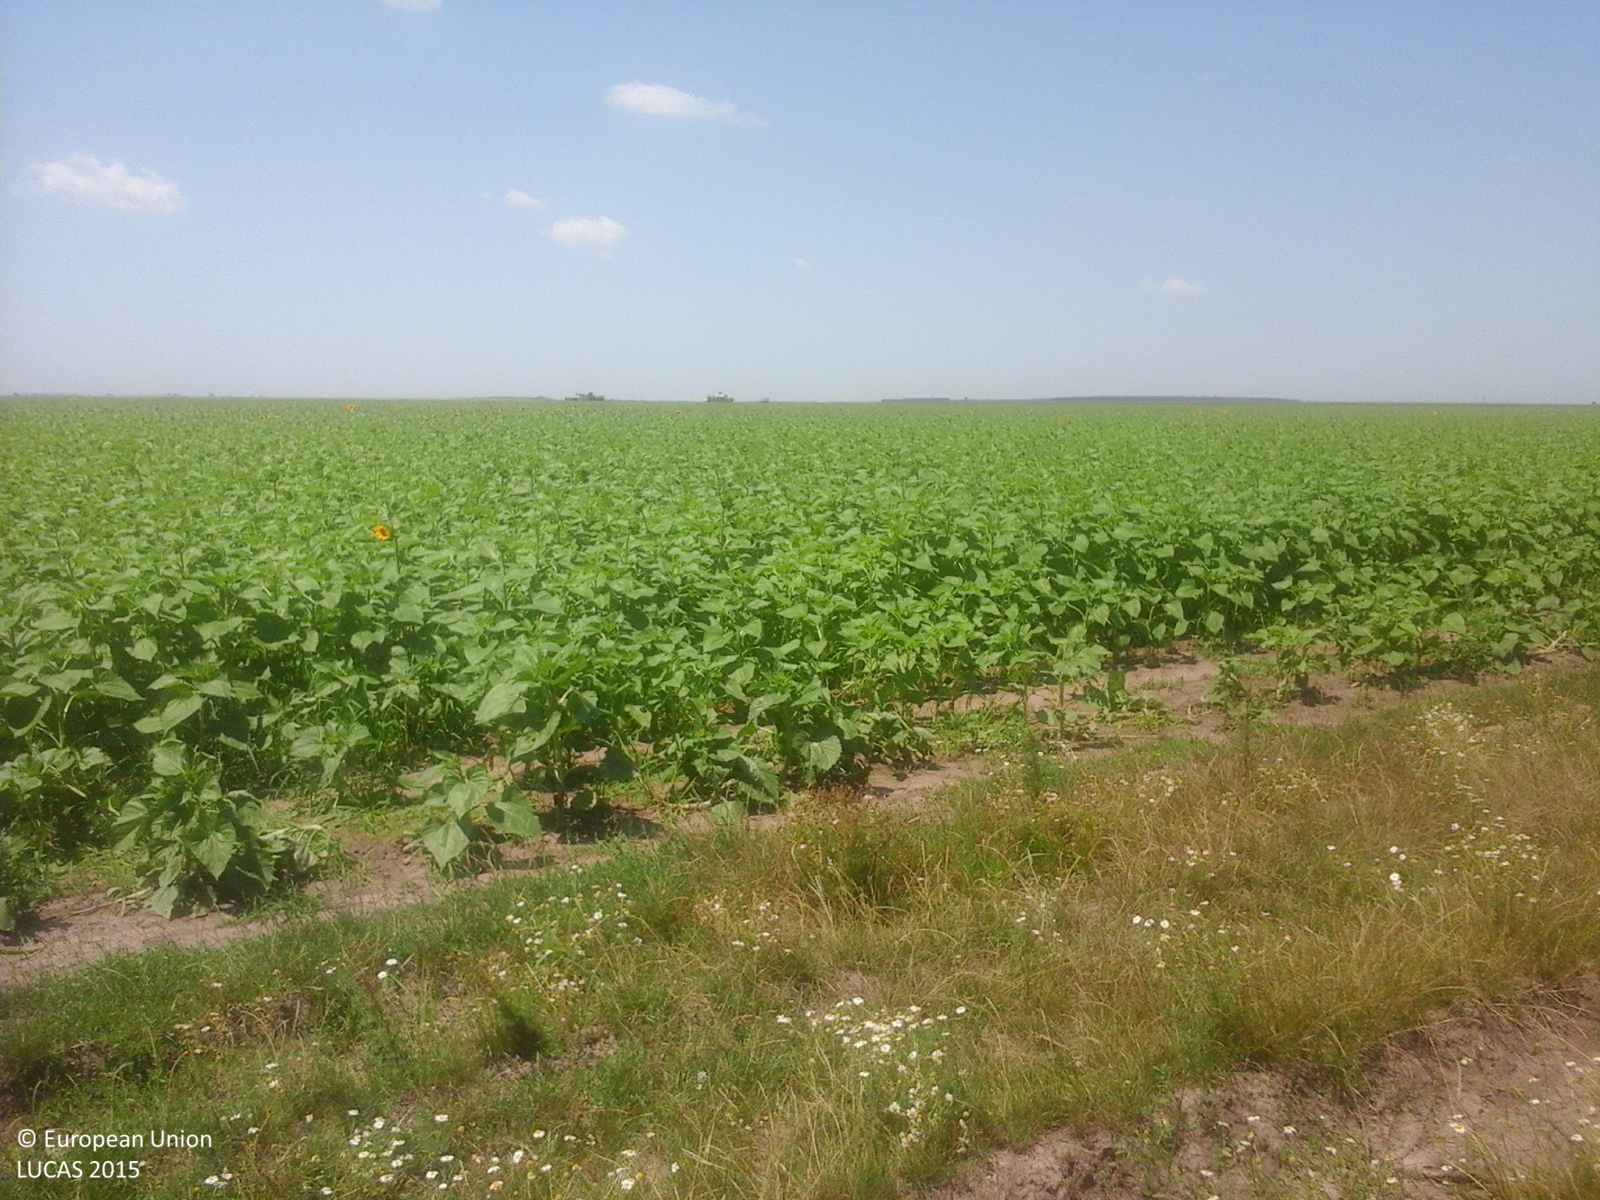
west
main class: Cropland
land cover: Sunflower
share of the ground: > 75 %
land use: Agriculture (excluding fallow land and kitchen gardens)
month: July
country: RO
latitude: 44.2084
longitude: 24.7276
